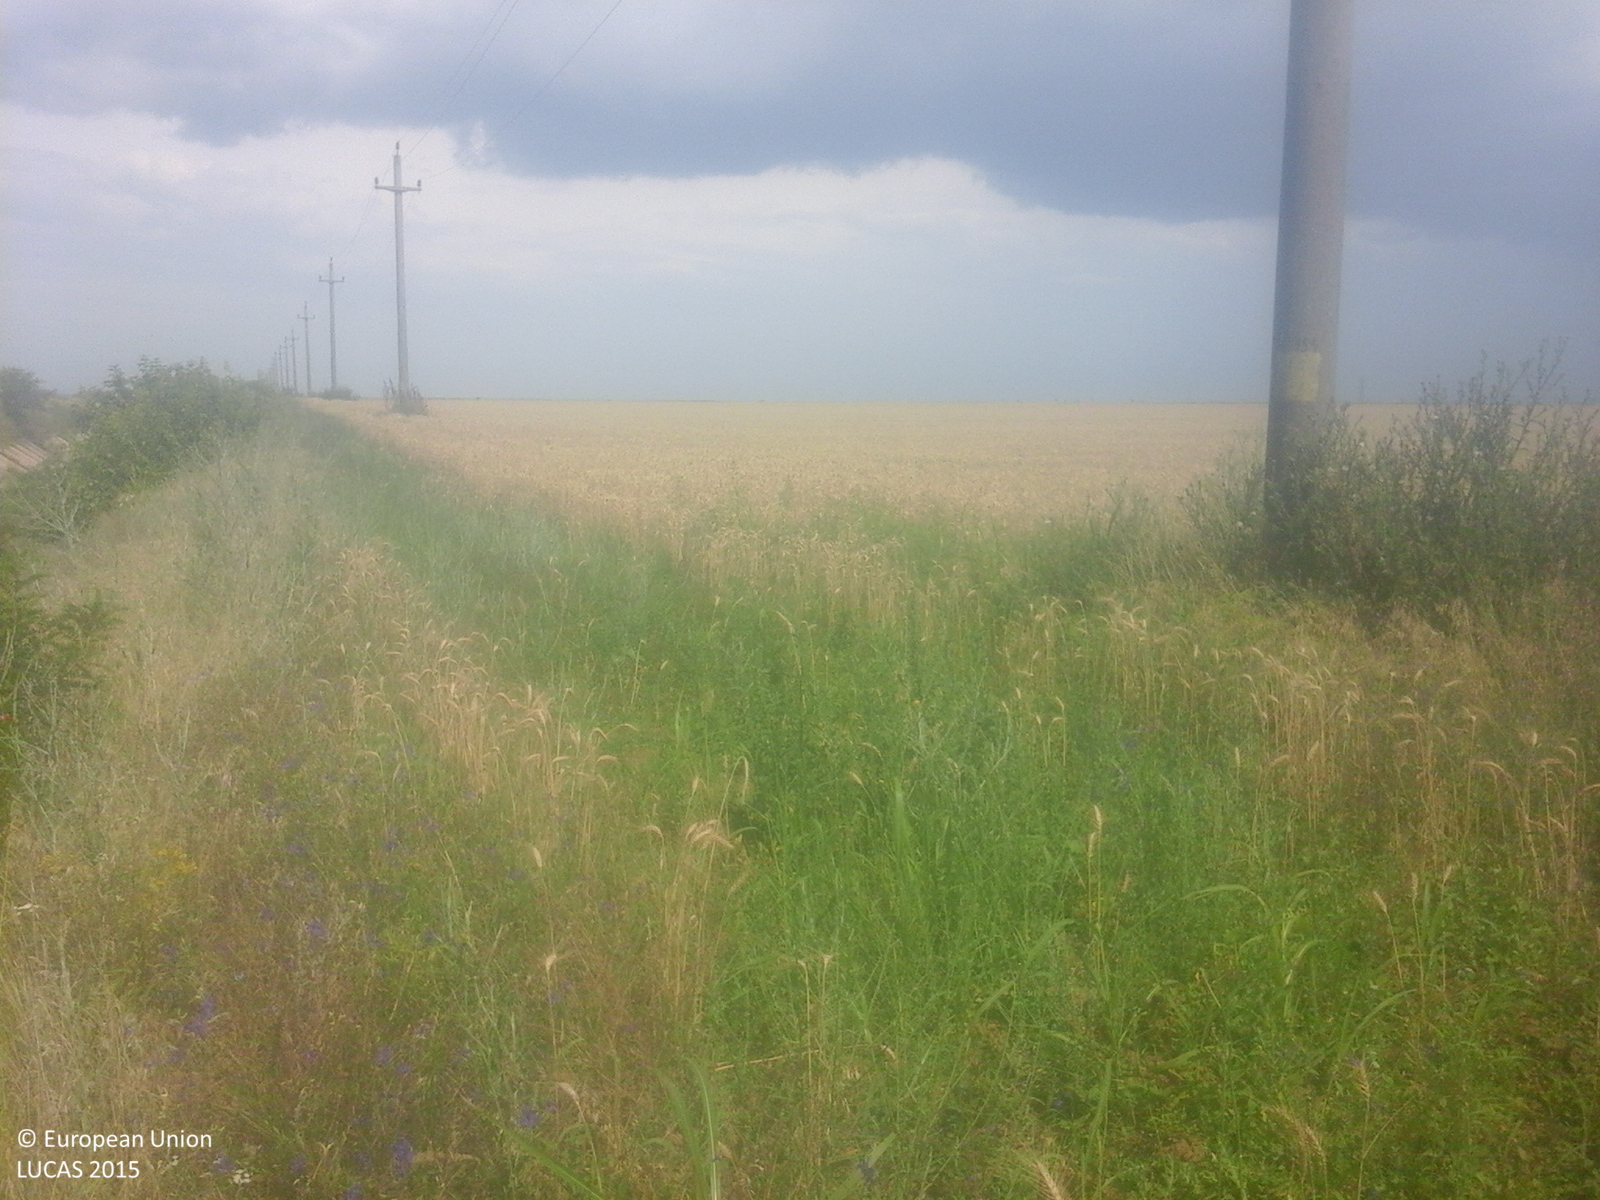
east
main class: Grassland
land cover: Spontaneously vegetated surfaces
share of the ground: > 75 %
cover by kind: herbaceous plants 100 %
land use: Fallow land
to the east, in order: Spontaneously vegetated surfaces; Common wheat; Electric lines; Common wheat; Spontaneously vegetated surfaces; Common wheat
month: July
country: RO
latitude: 43.8130
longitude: 24.5488
